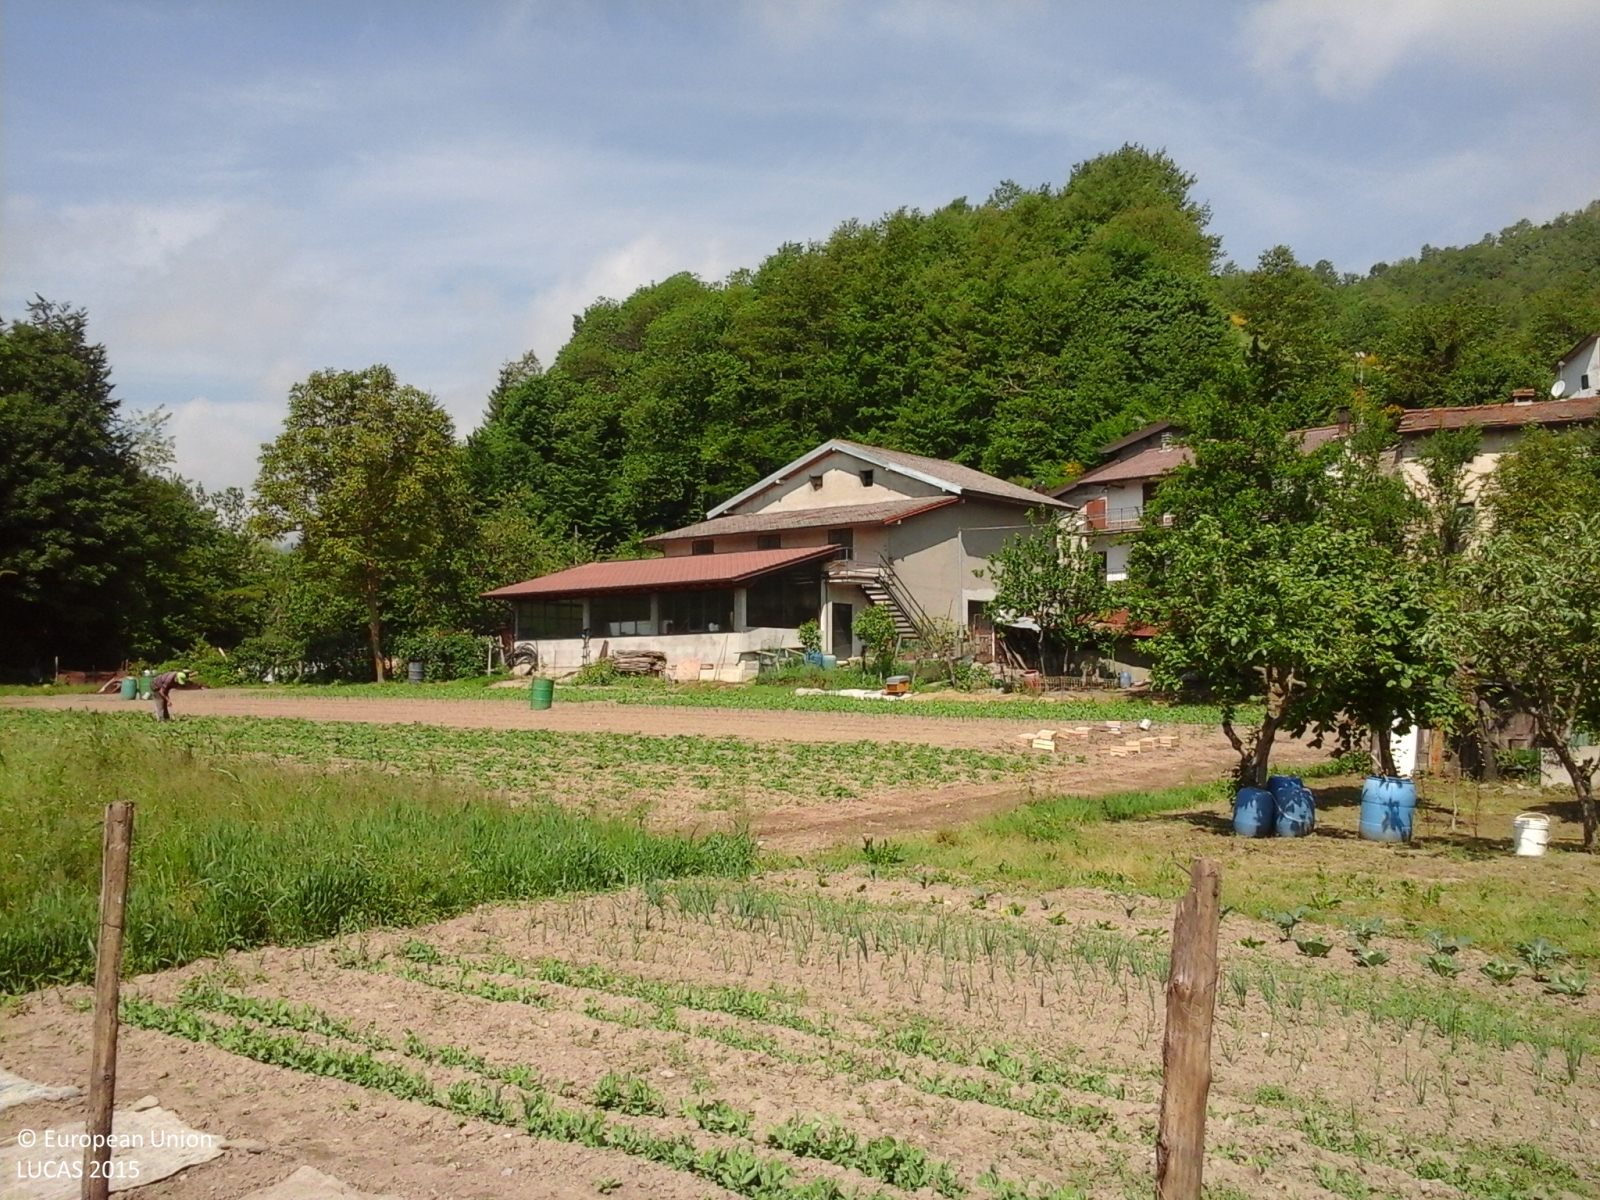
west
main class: Cropland
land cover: Other fresh vegetables
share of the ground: > 75 %
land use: Agriculture (excluding fallow land and kitchen gardens)
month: May
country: IT
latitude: 44.0915
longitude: 11.1588
